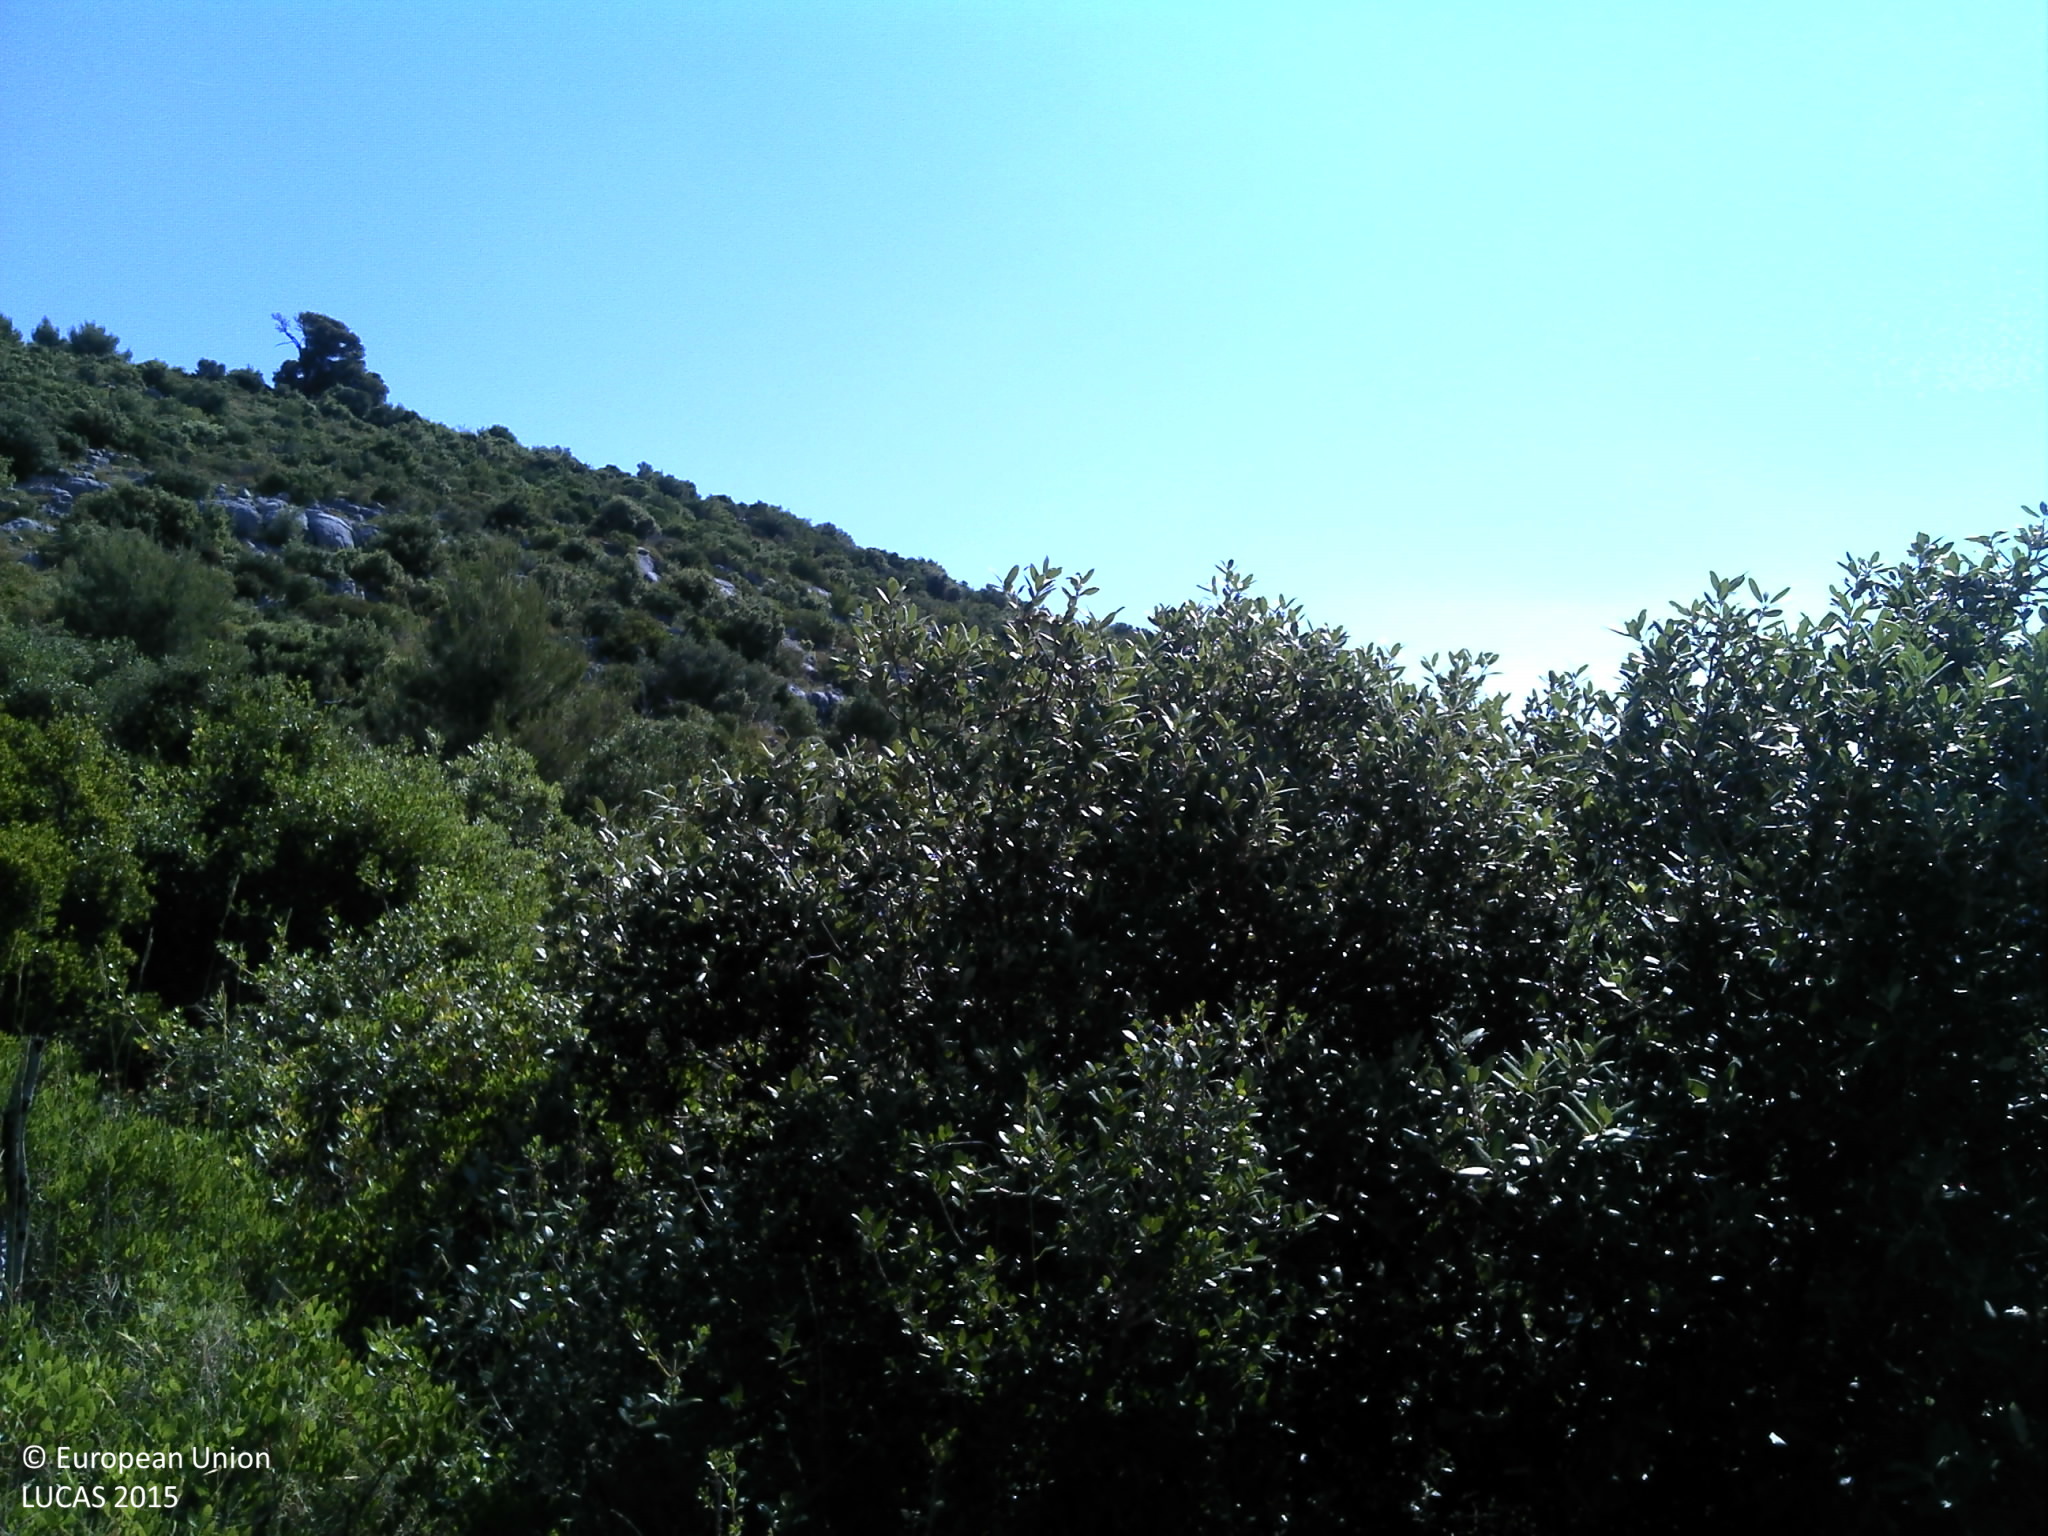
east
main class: Shrubland
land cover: Shrubland without tree cover
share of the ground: 25 - 50 %
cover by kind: shrubs 50 %, consolidated bare surface 20 %, unconsolidated bare surface 20 %, herbaceous plants 10 %
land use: Semi-natural and natural areas not in use
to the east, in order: Shrubland without tree cover
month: June
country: HR
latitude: 43.5205
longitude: 16.0896
